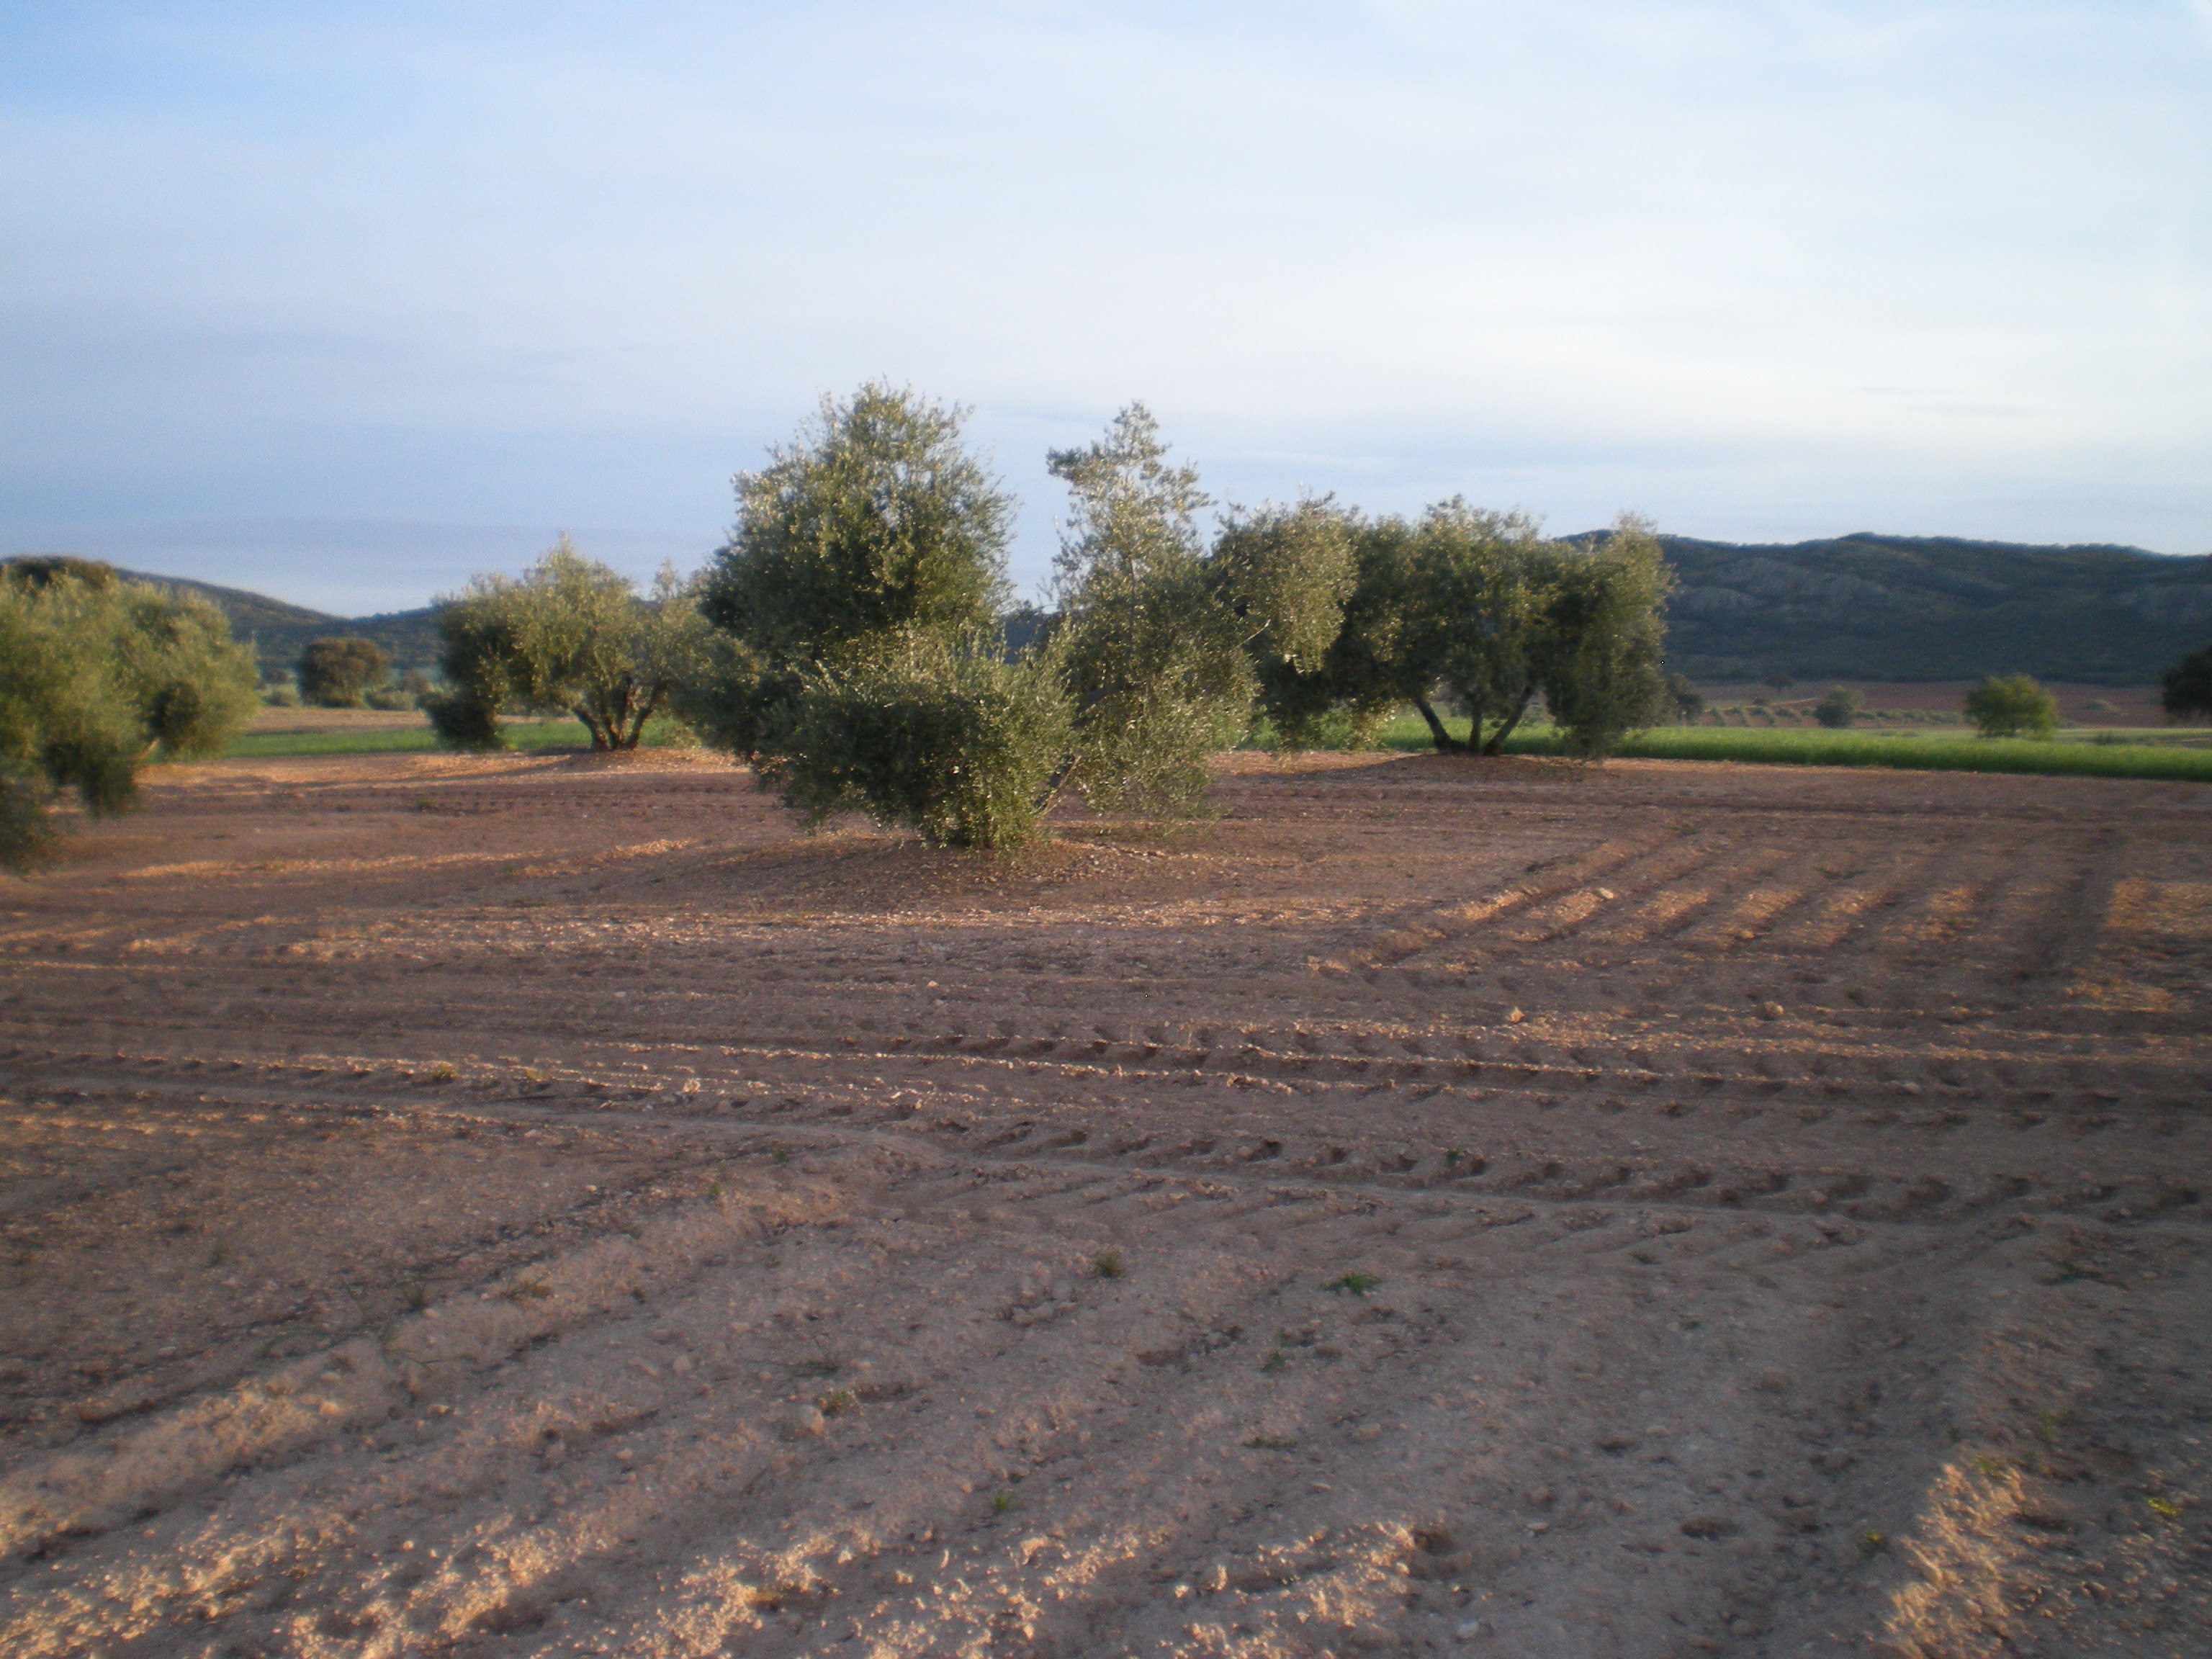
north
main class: Cropland
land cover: Olive groves
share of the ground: 10 - 25 %
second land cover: Other bare soil
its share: > 75 %
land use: Agriculture (excluding fallow land and kitchen gardens)
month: April
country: ES
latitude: 38.5577
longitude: -3.1220
